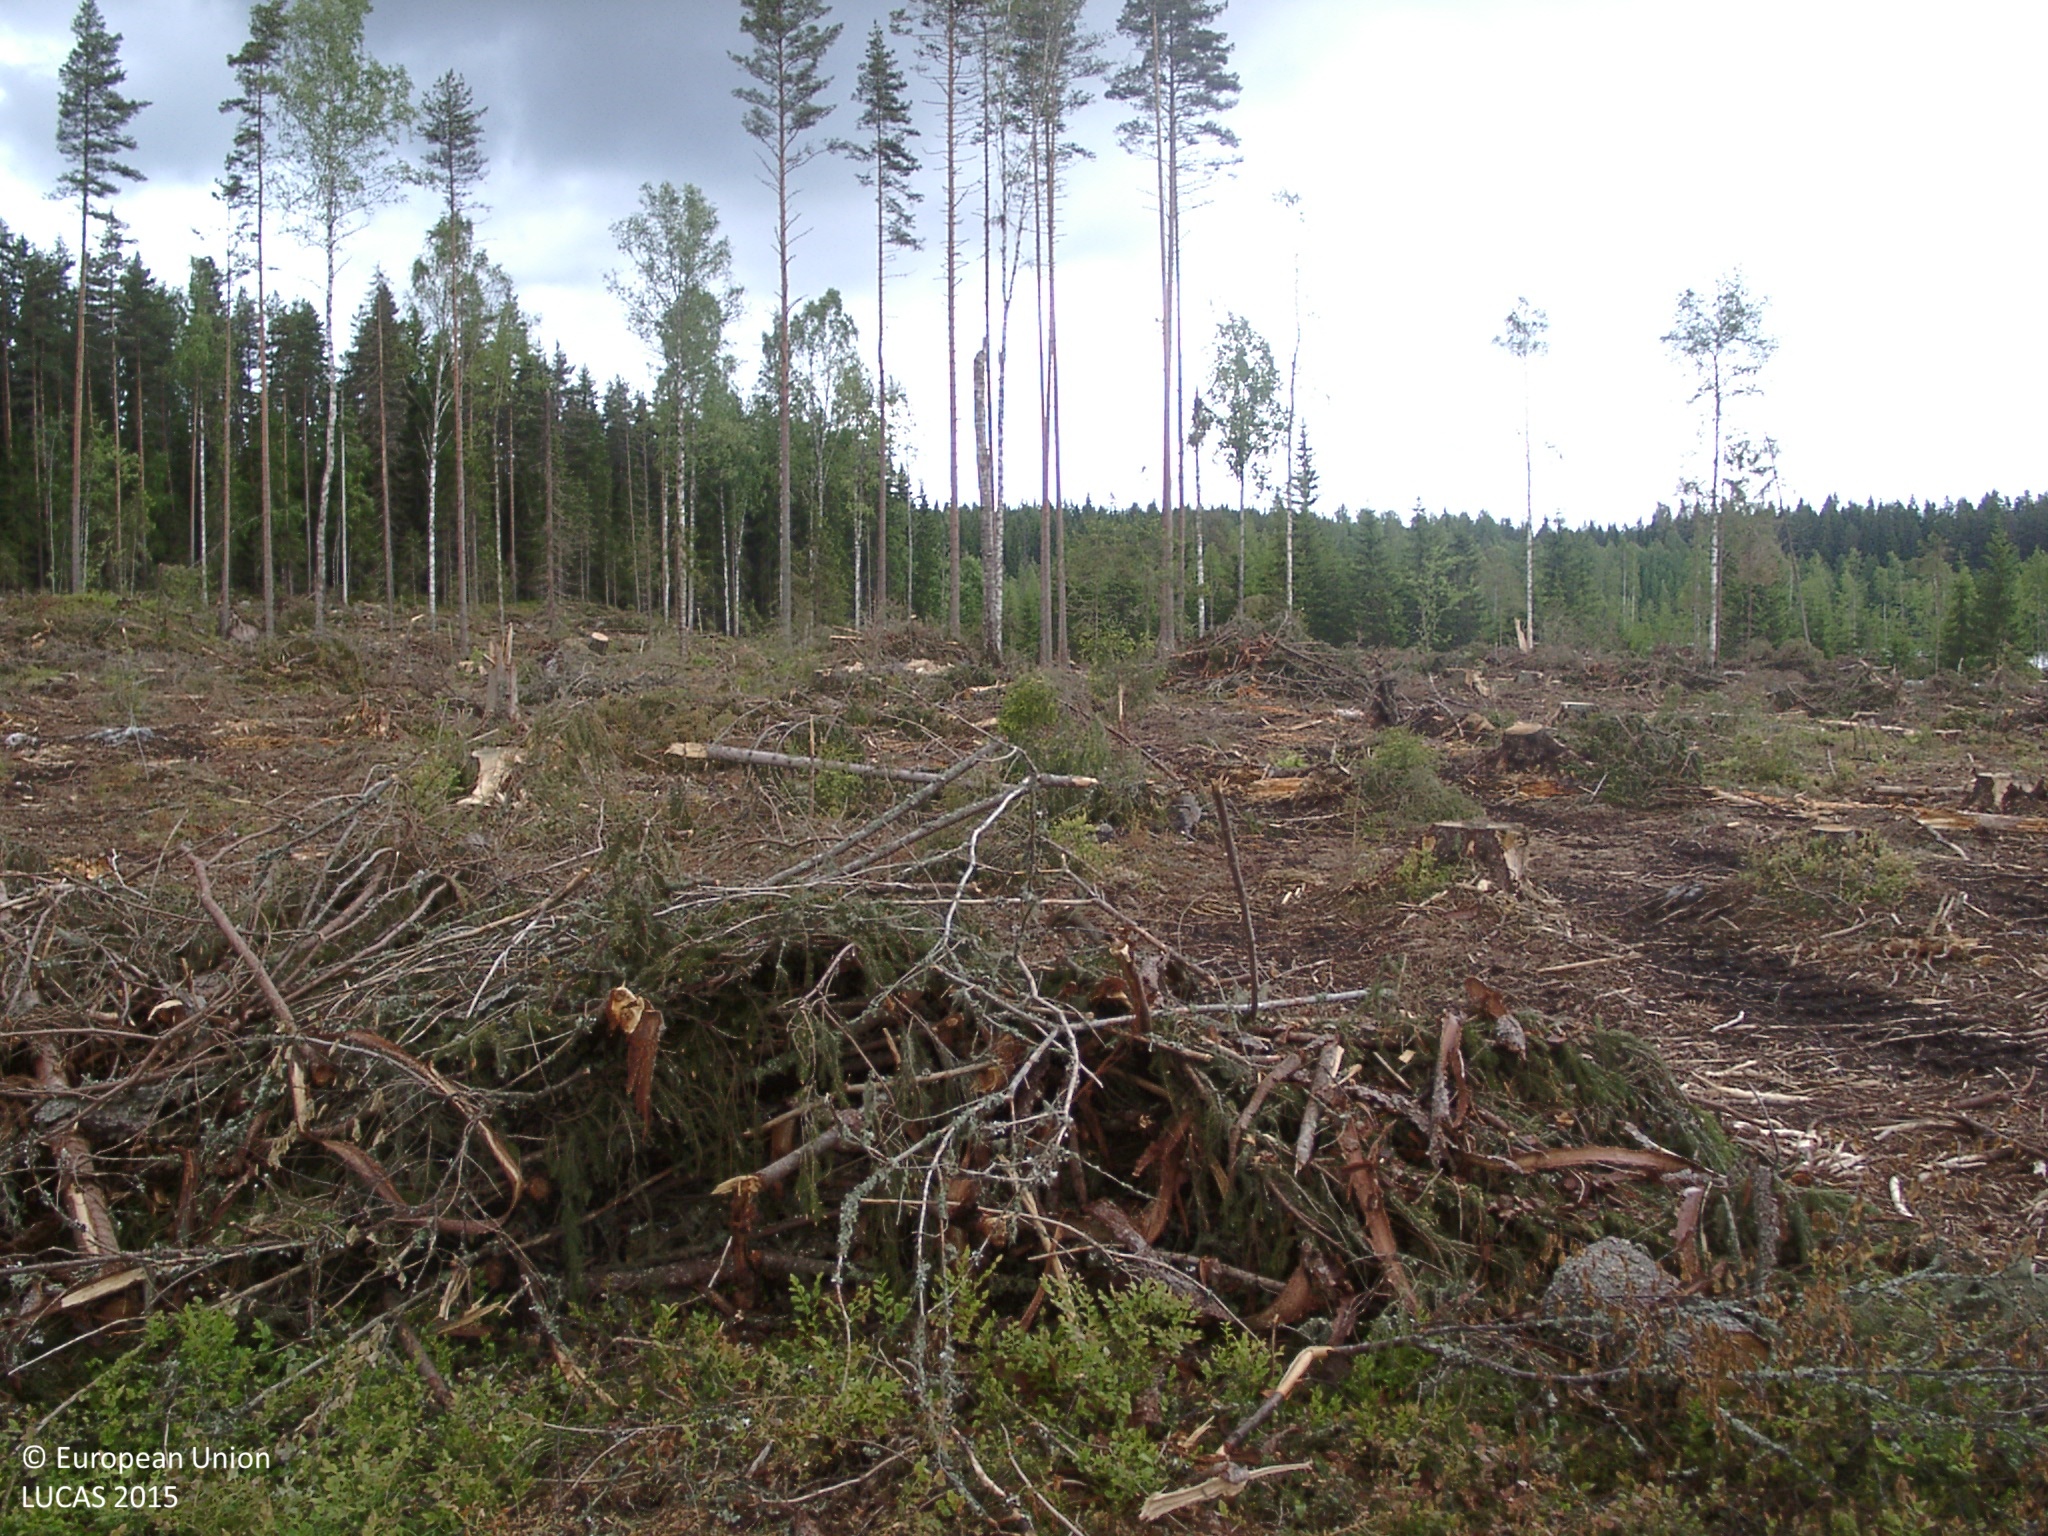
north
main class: Shrubland
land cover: Shrubland with sparse tree cover
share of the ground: 10 - 25 %
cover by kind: unconsolidated bare surface 50 %, shrubs 10 %, broadleaved forest trees 5 %
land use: Forestry
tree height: > 5 m
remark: Clear cut
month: June
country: FI
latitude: 61.5792
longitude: 24.8144
